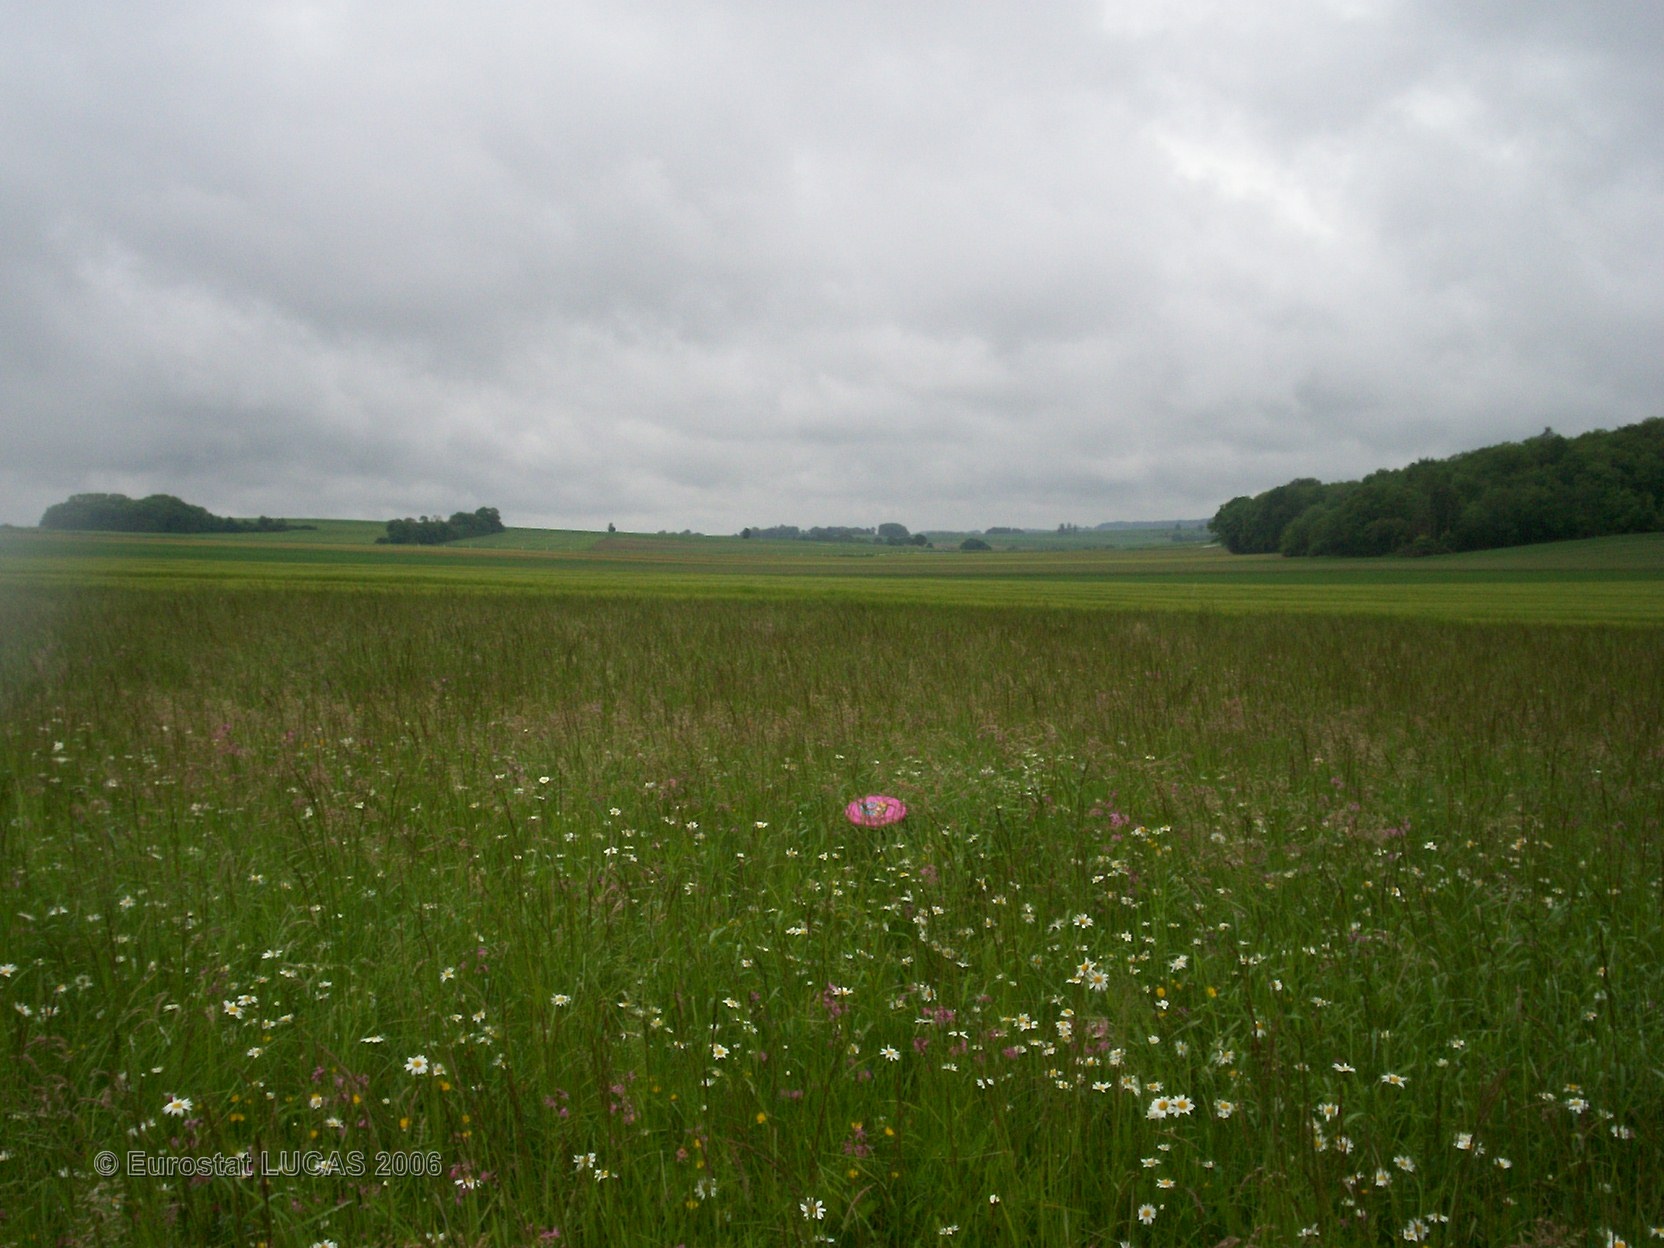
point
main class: Grassland
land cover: Grassland without tree/shrub cover
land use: Agriculture (excluding fallow land and kitchen gardens)
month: May
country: FR
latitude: 48.5378
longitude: 6.8178
